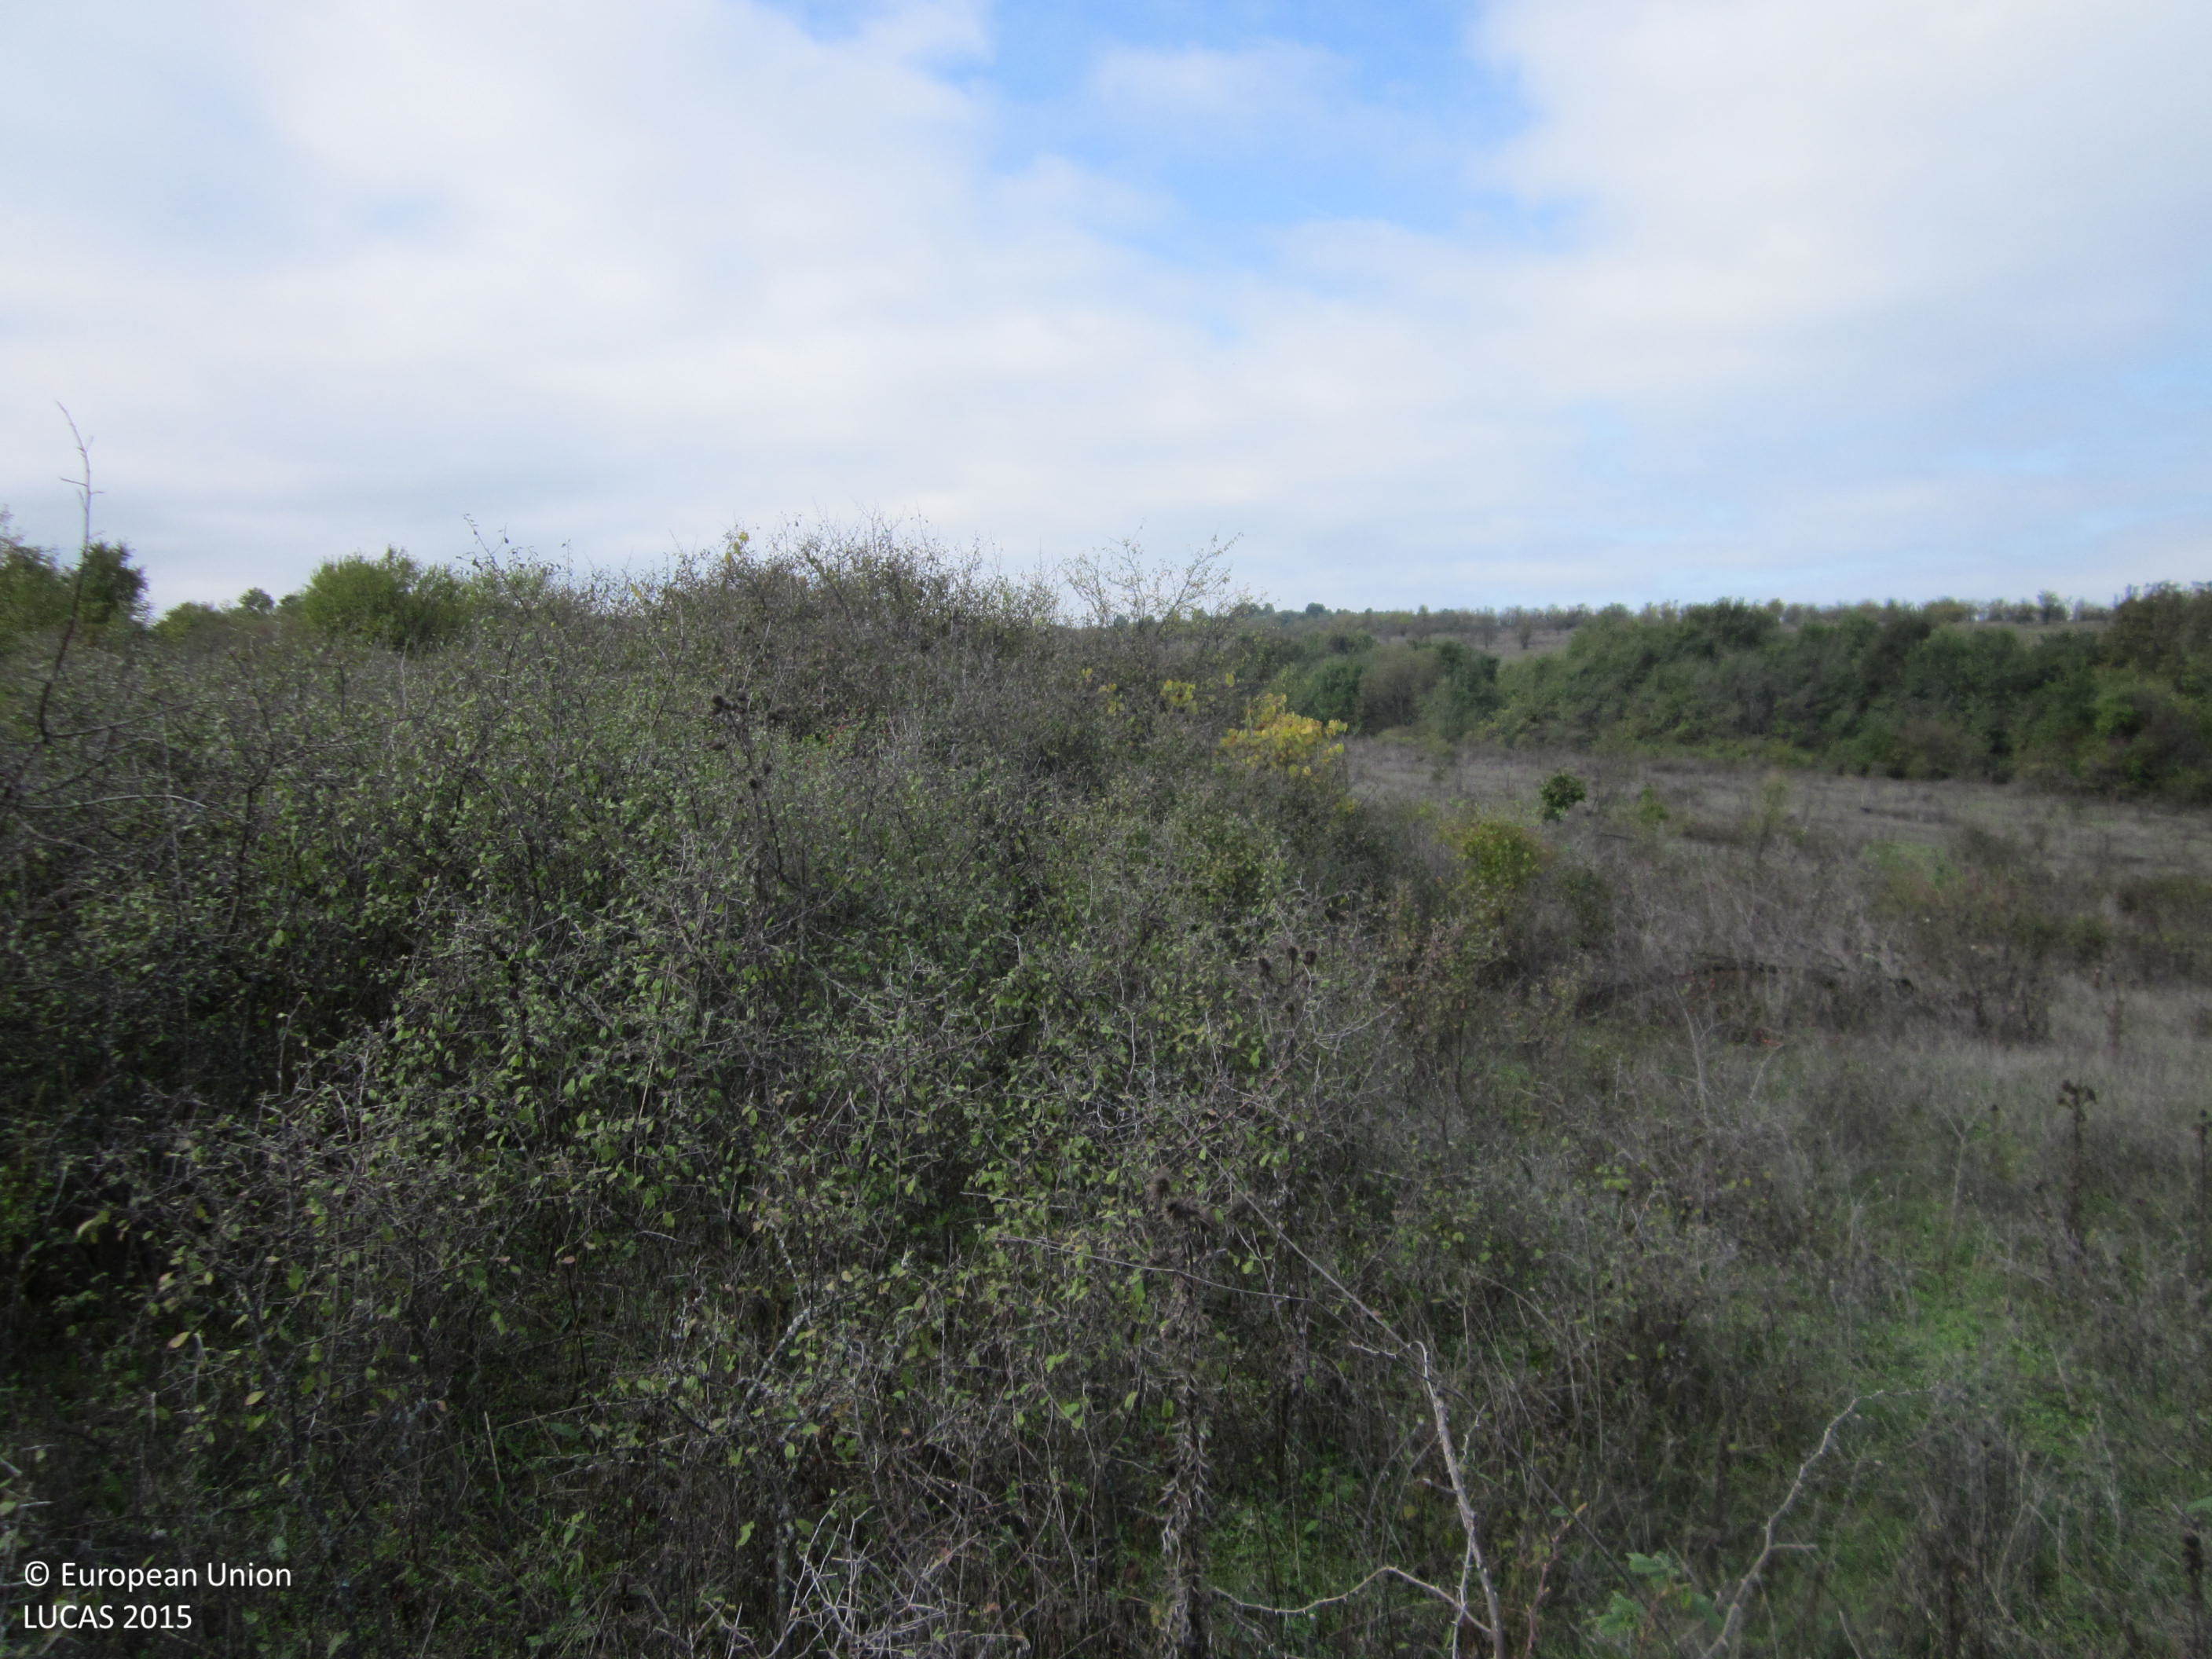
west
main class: Shrubland
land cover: Shrubland with sparse tree cover
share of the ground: > 75 %
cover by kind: shrubs 80 %, herbaceous plants 15 %, broadleaved forest trees 5 %
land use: Semi-natural and natural areas not in use
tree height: < 5 m
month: October
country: BG
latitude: 42.3291
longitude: 27.2066
